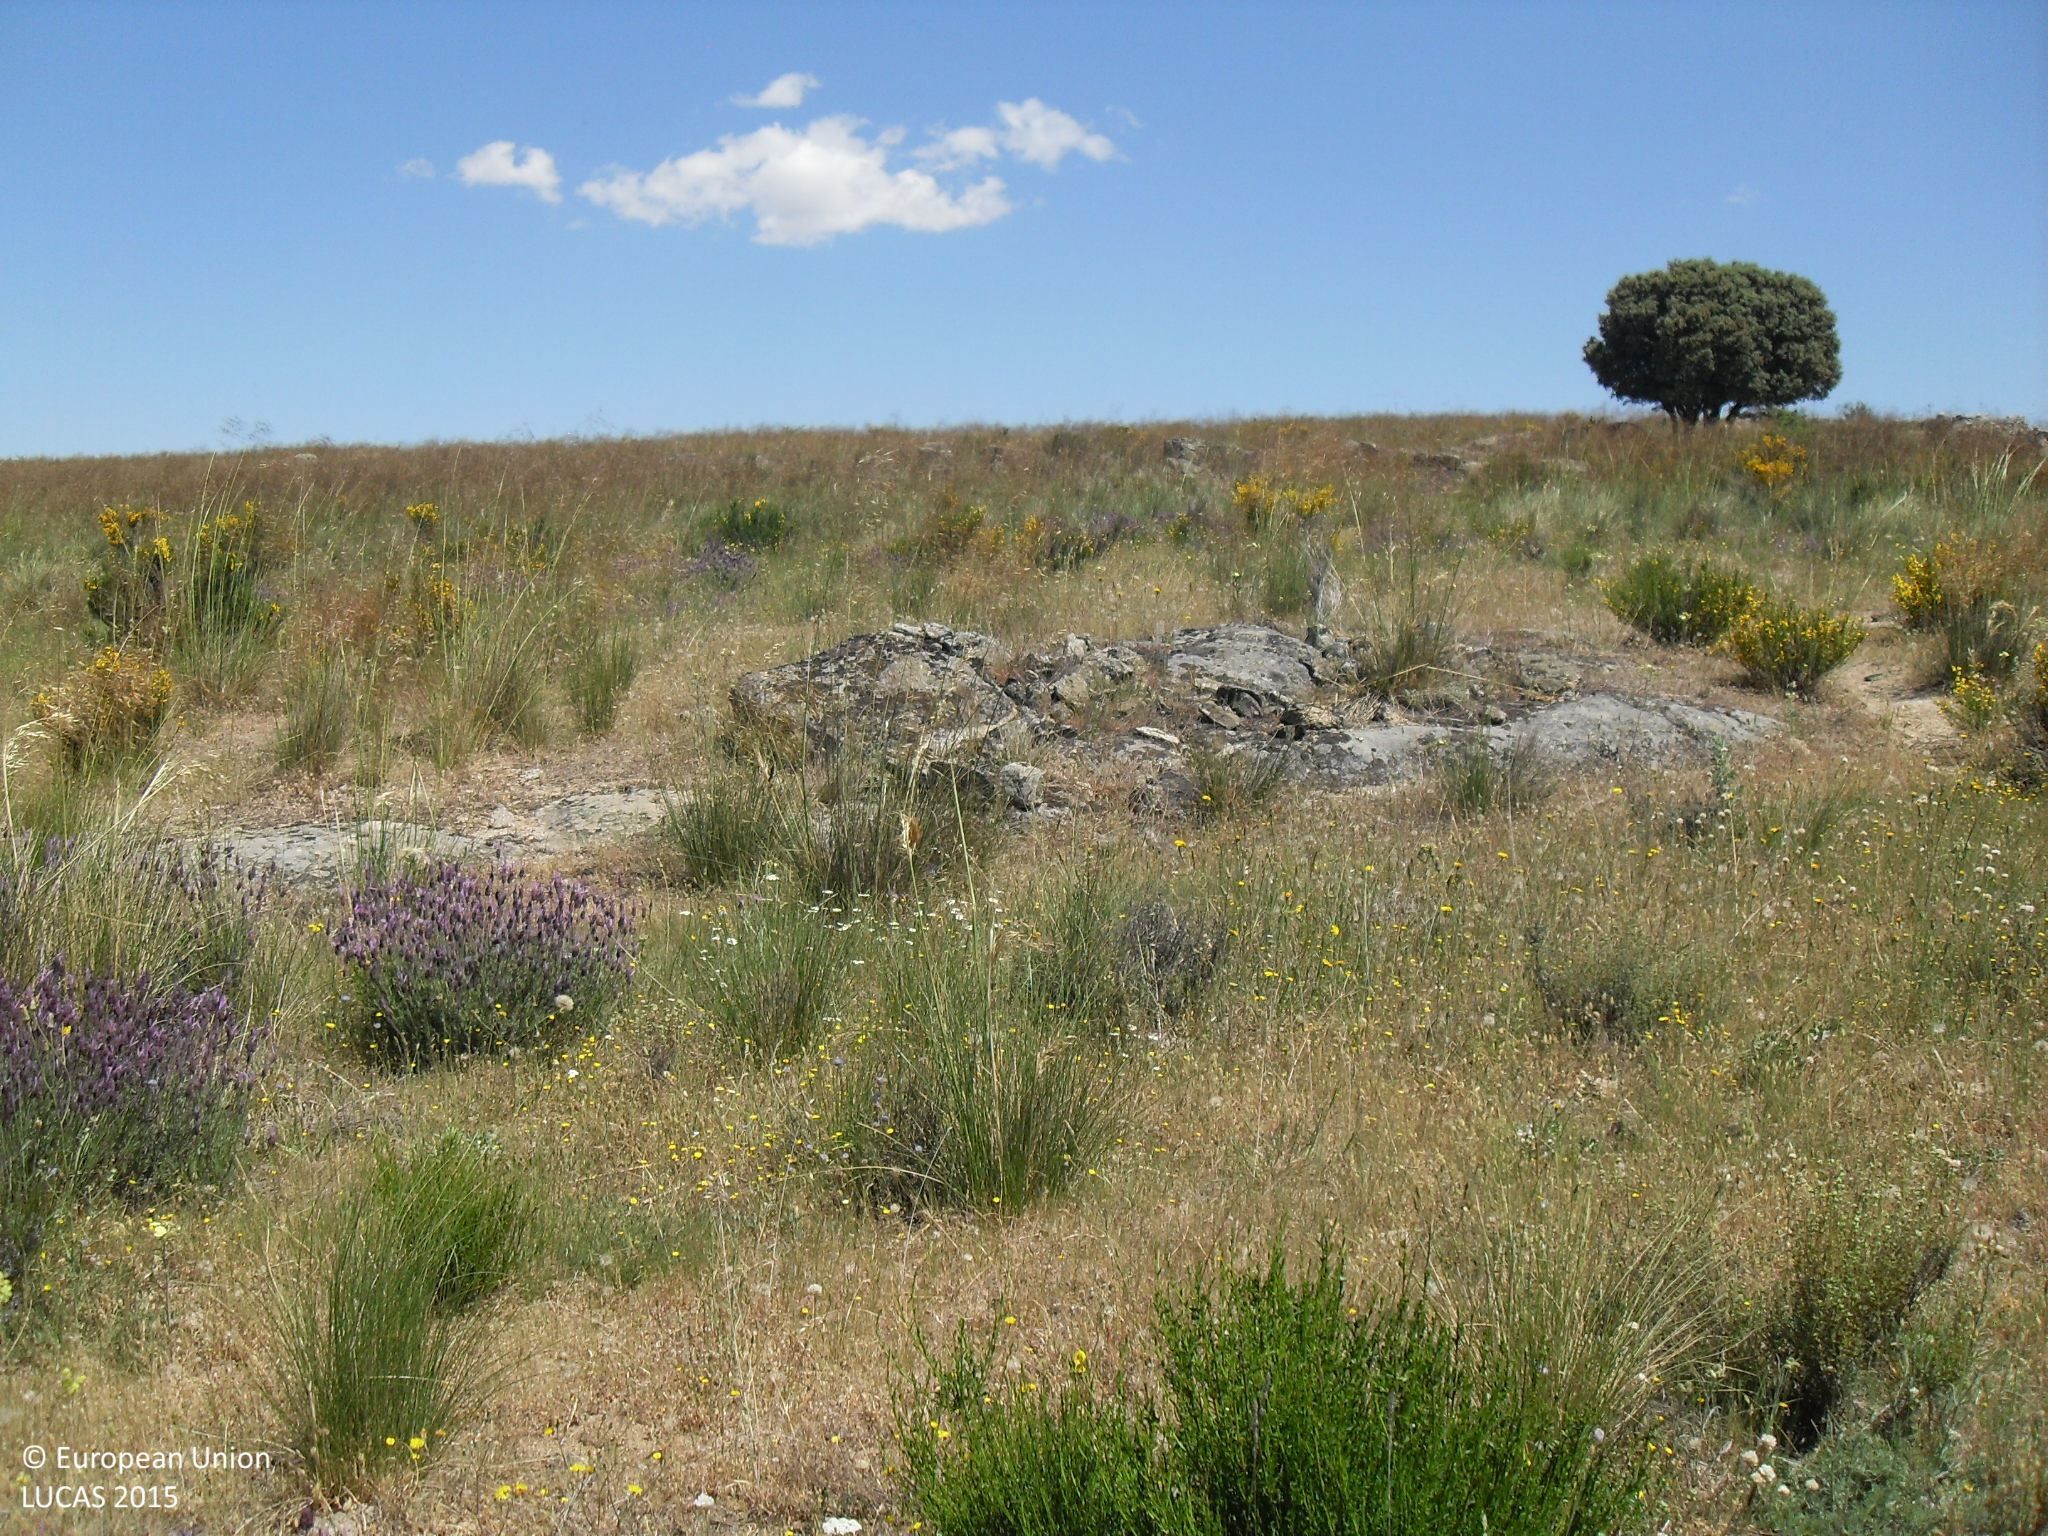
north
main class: Grassland
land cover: Grassland without tree/shrub cover
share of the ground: > 75 %
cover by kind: herbaceous plants 100 %
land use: Agriculture (excluding fallow land and kitchen gardens)
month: June
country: ES
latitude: 40.5887
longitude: -5.2708
